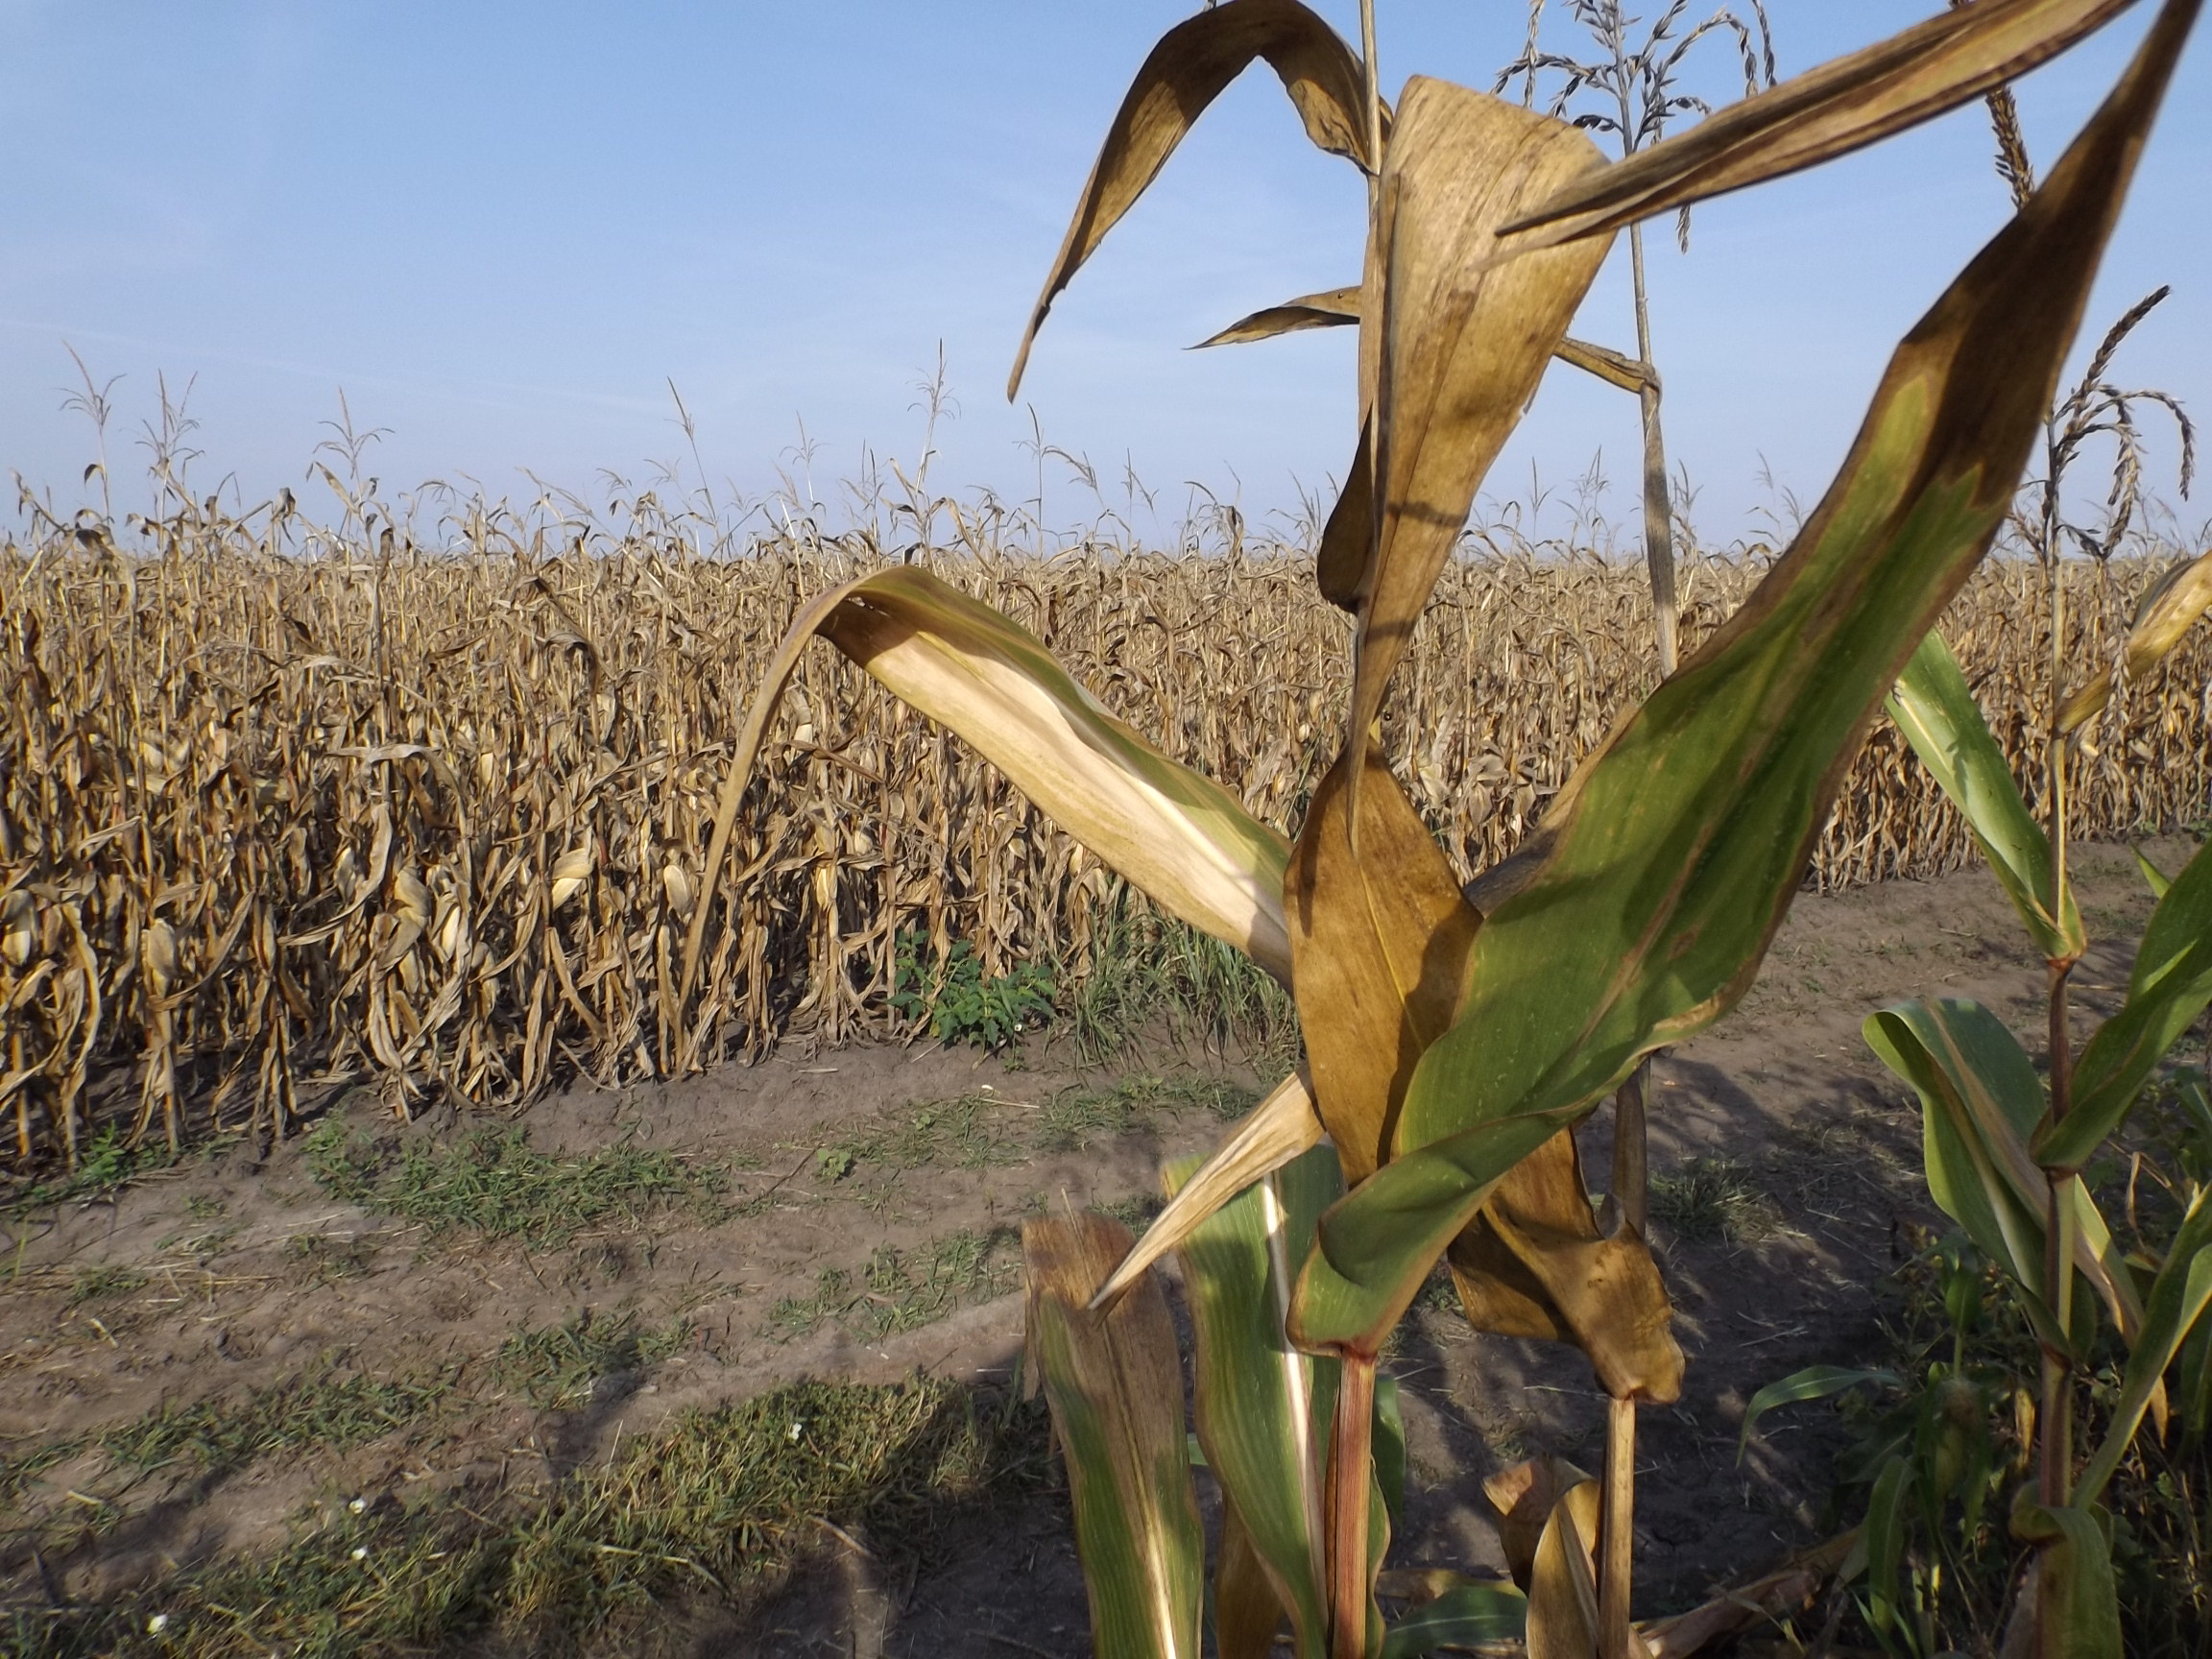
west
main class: Cropland
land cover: Maize
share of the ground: > 75 %
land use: Agriculture (excluding fallow land and kitchen gardens)
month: September
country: BG
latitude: 44.0073
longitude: 26.4096
